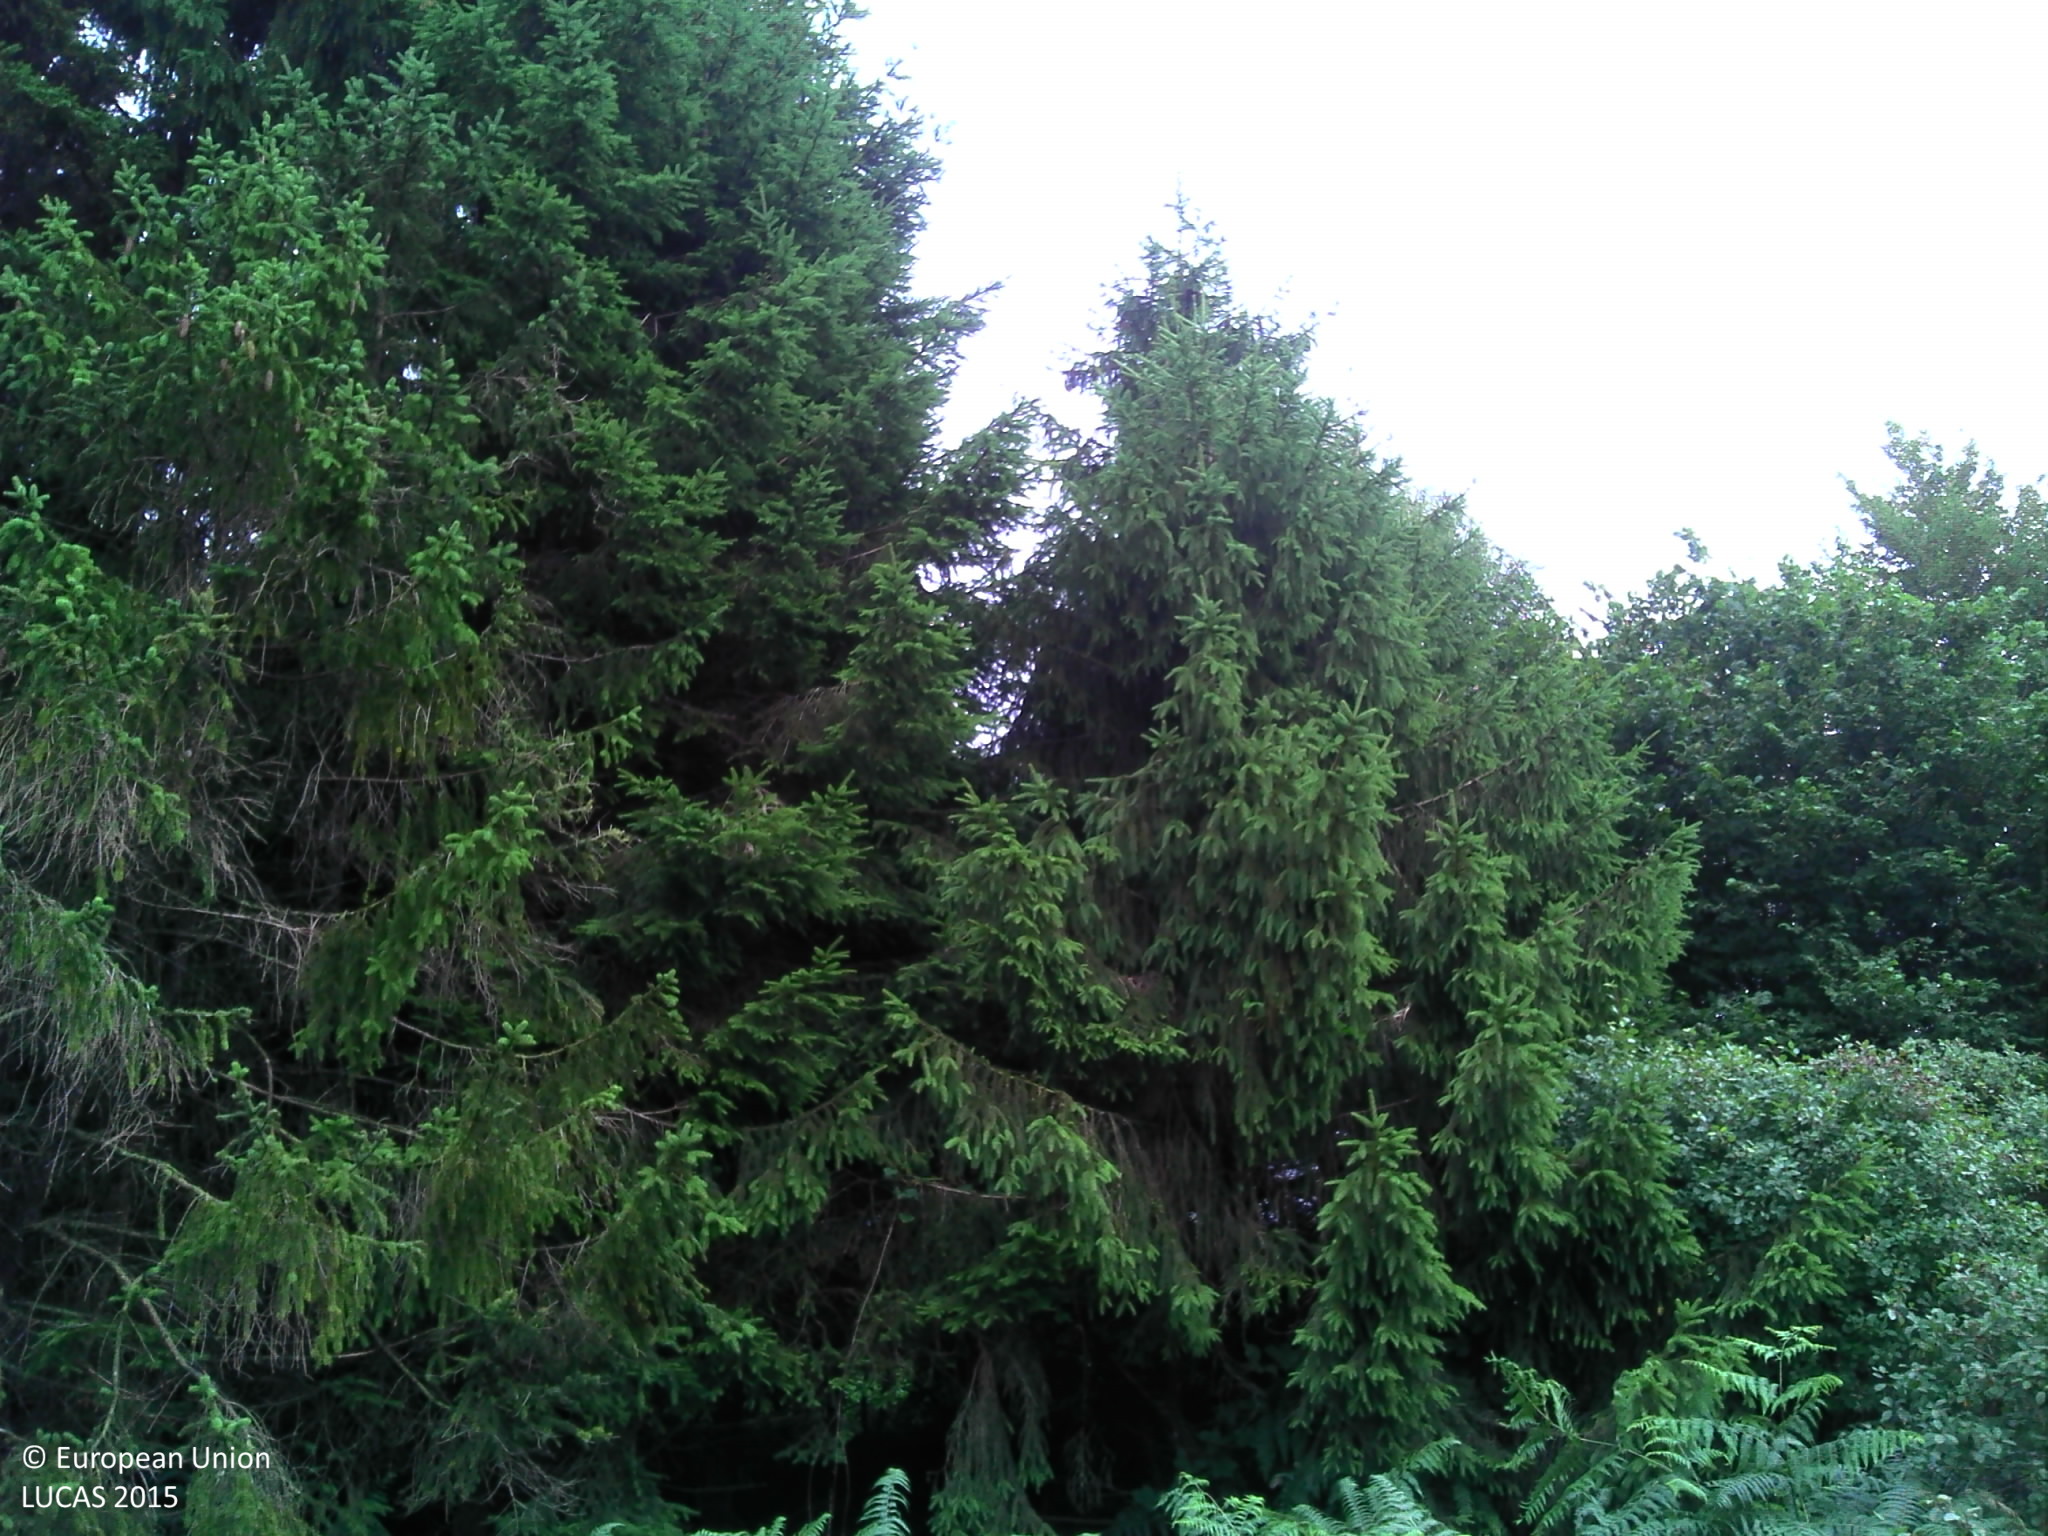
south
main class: Grassland
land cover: Spontaneously vegetated surfaces
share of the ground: > 75 %
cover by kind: herbaceous plants 95 %, shrubs 5 %
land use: Semi-natural and natural areas not in use
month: August
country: FR
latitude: 48.3644
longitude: -3.1239
